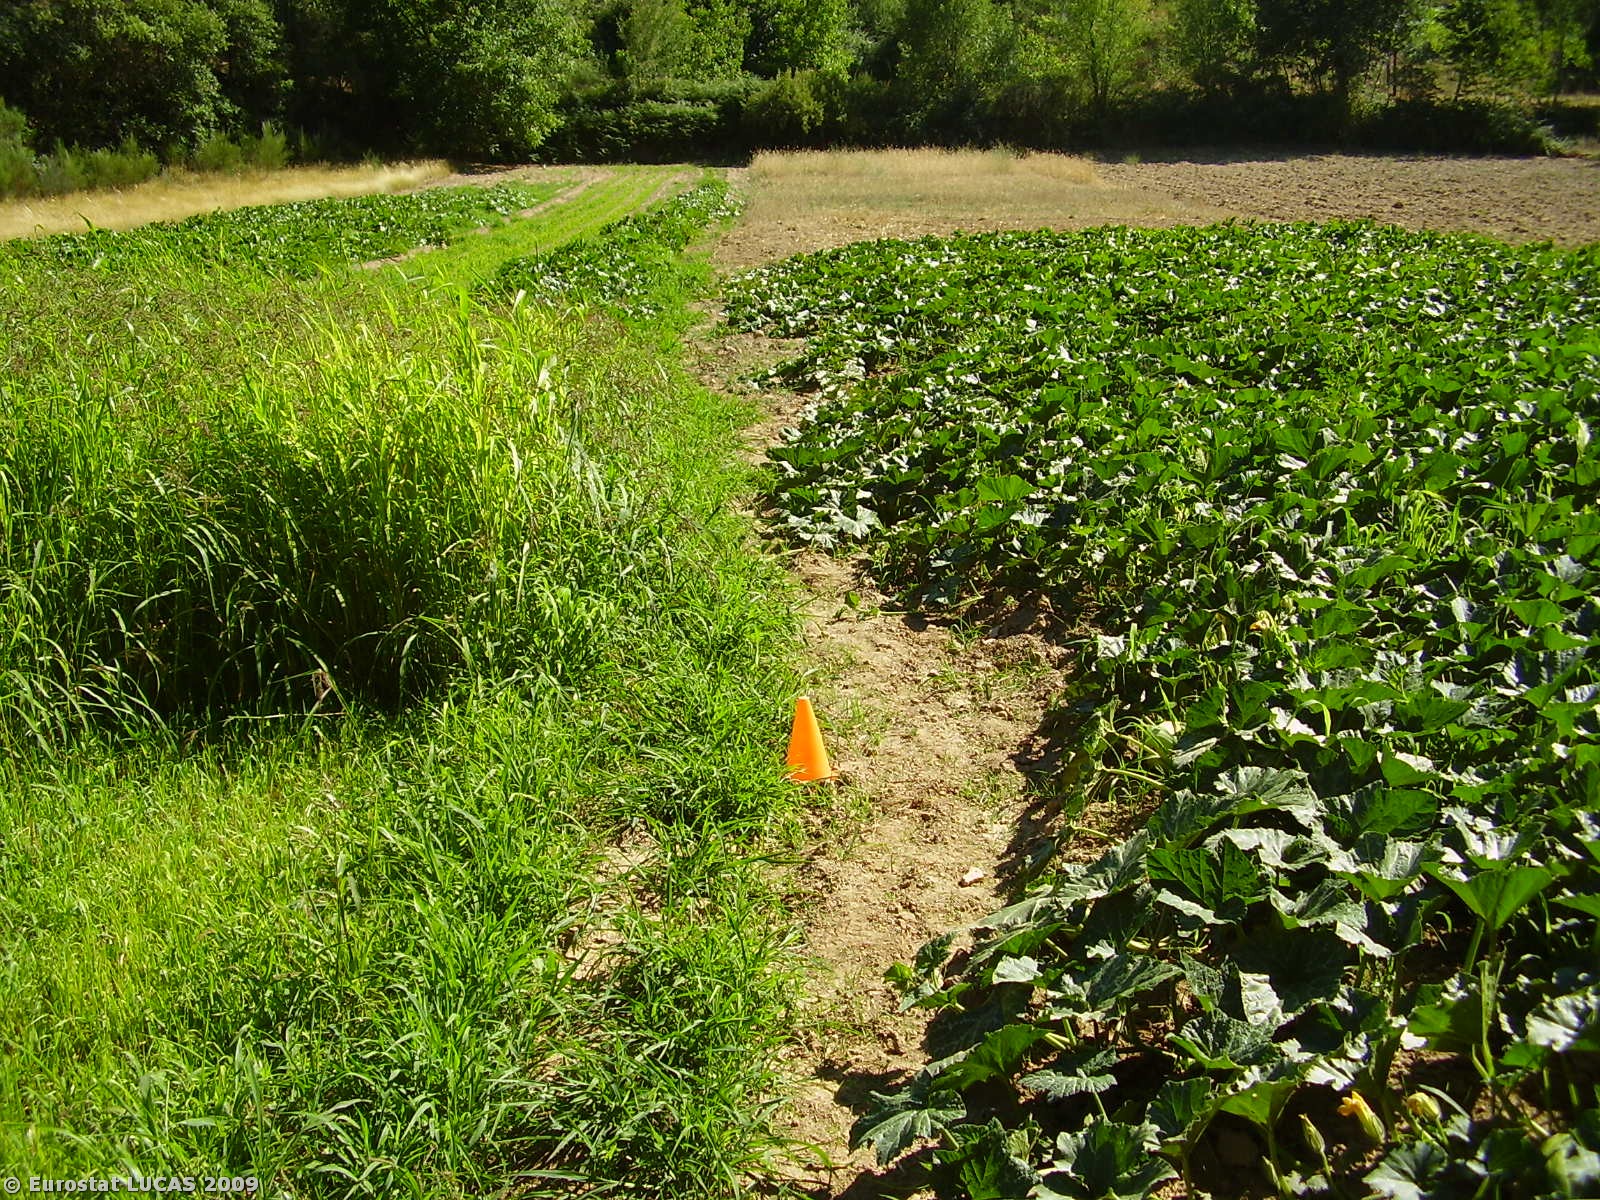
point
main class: Cropland
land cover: Mixed cereals for fodder
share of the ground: > 75 %
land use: Agriculture (excluding fallow land and kitchen gardens)
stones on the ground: < 10 %
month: July
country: PT
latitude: 41.6361
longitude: -7.3768
